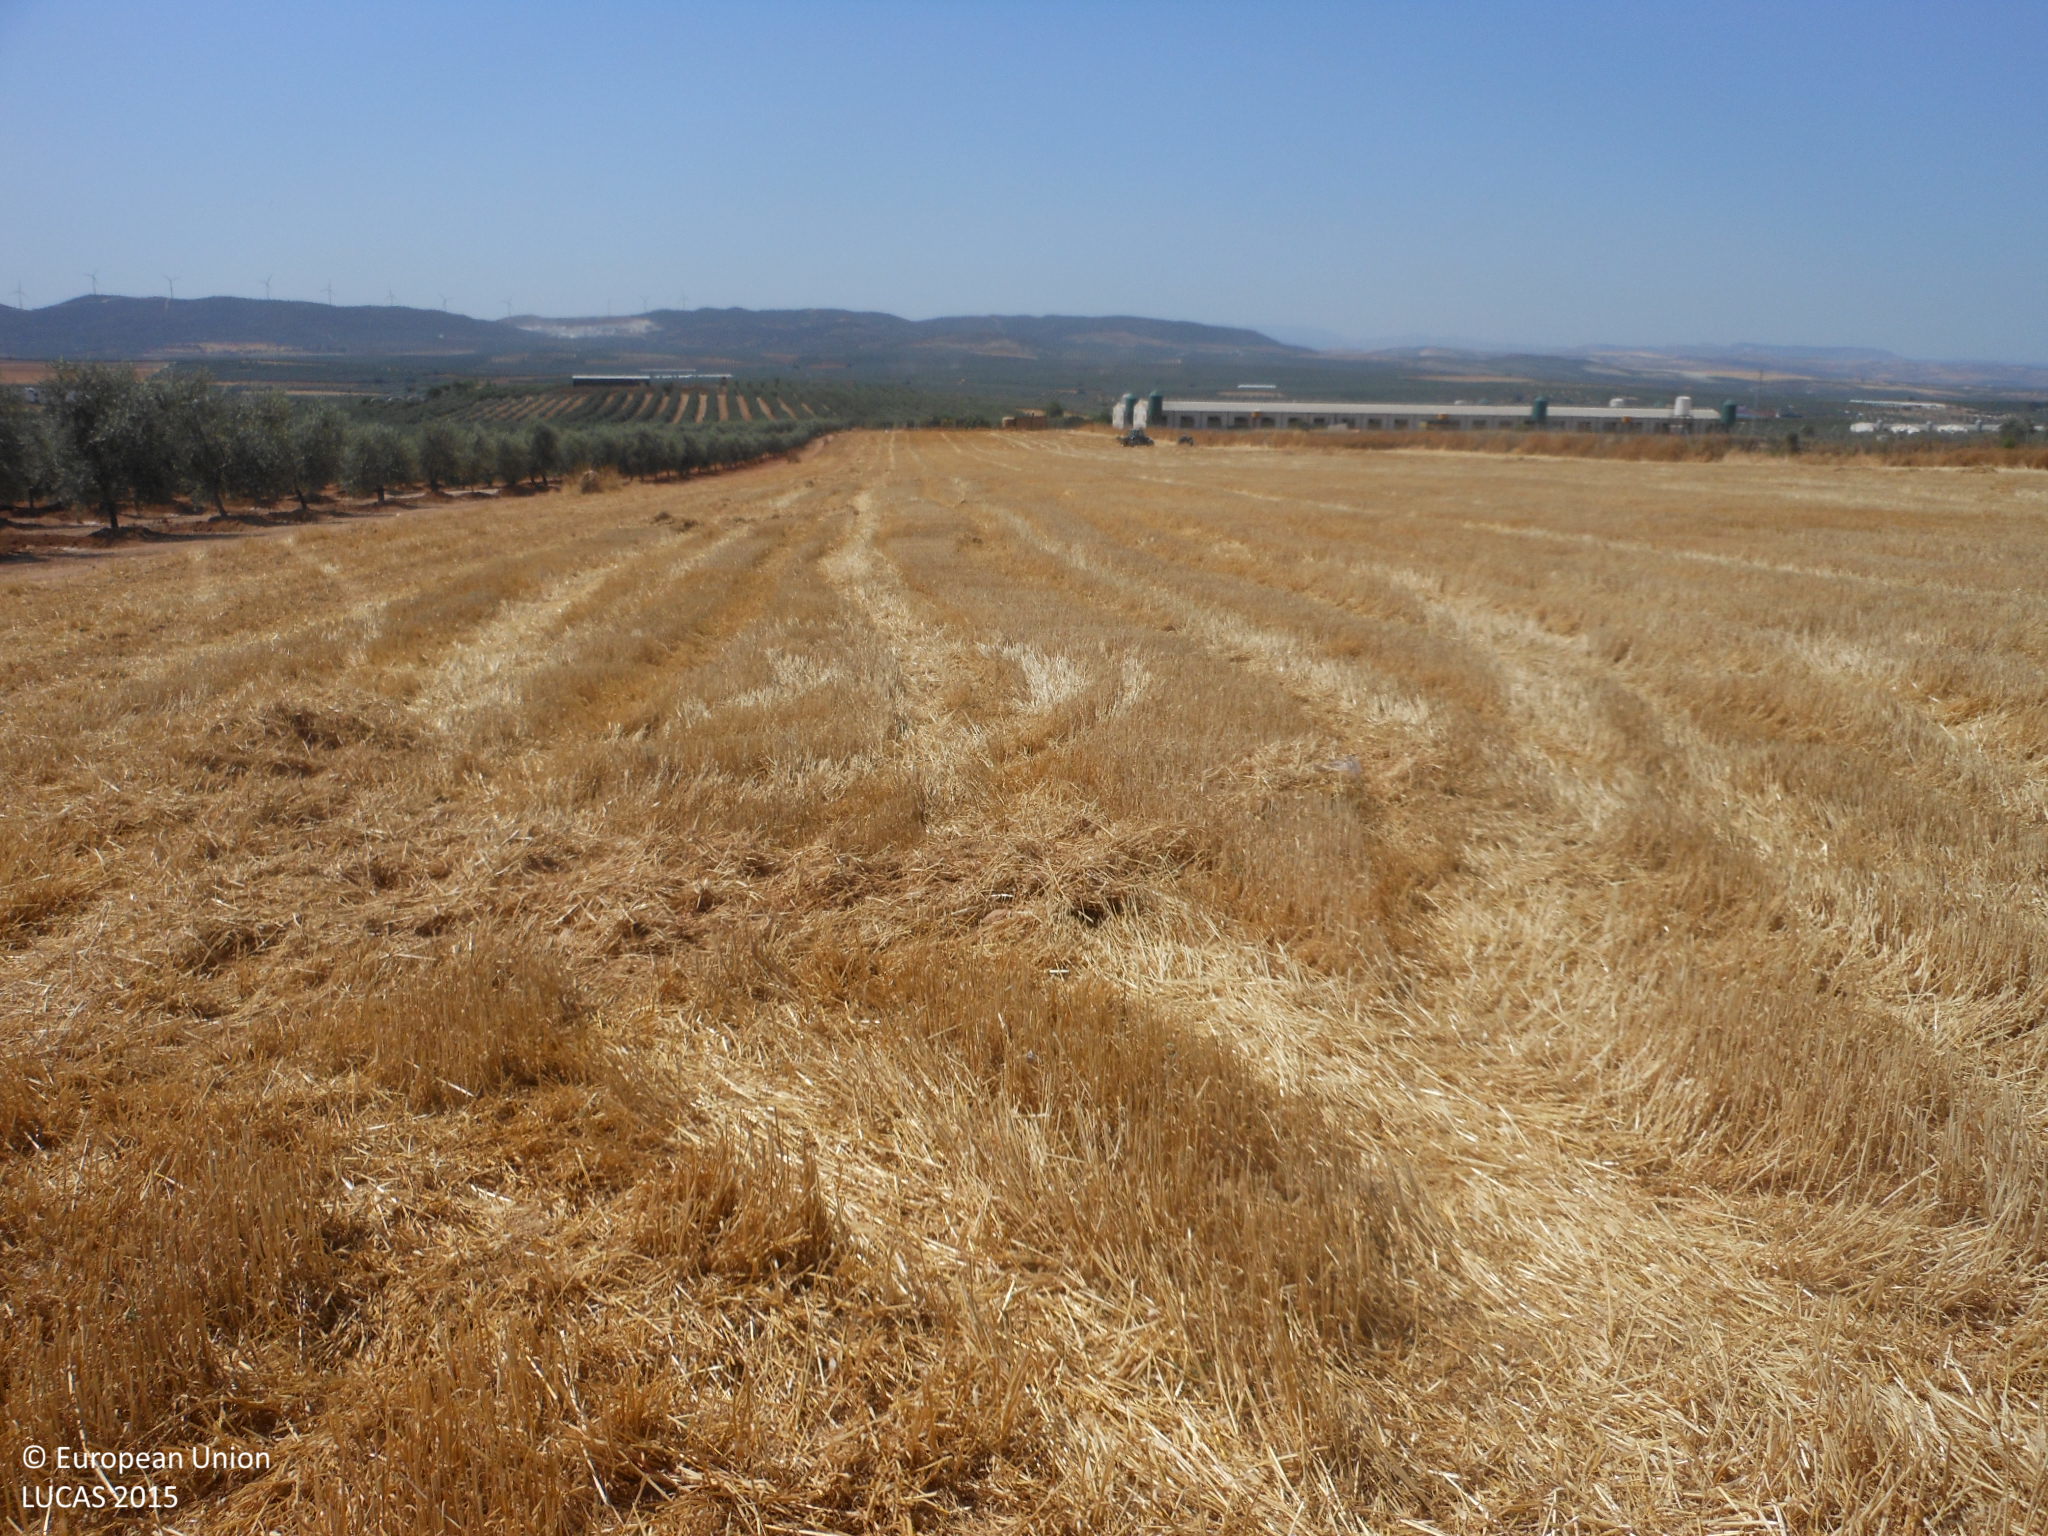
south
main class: Cropland
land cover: Barley
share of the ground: < 10 %
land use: Agriculture (excluding fallow land and kitchen gardens)
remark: Harvested field
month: June
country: ES
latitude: 37.2336
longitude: -4.8716
